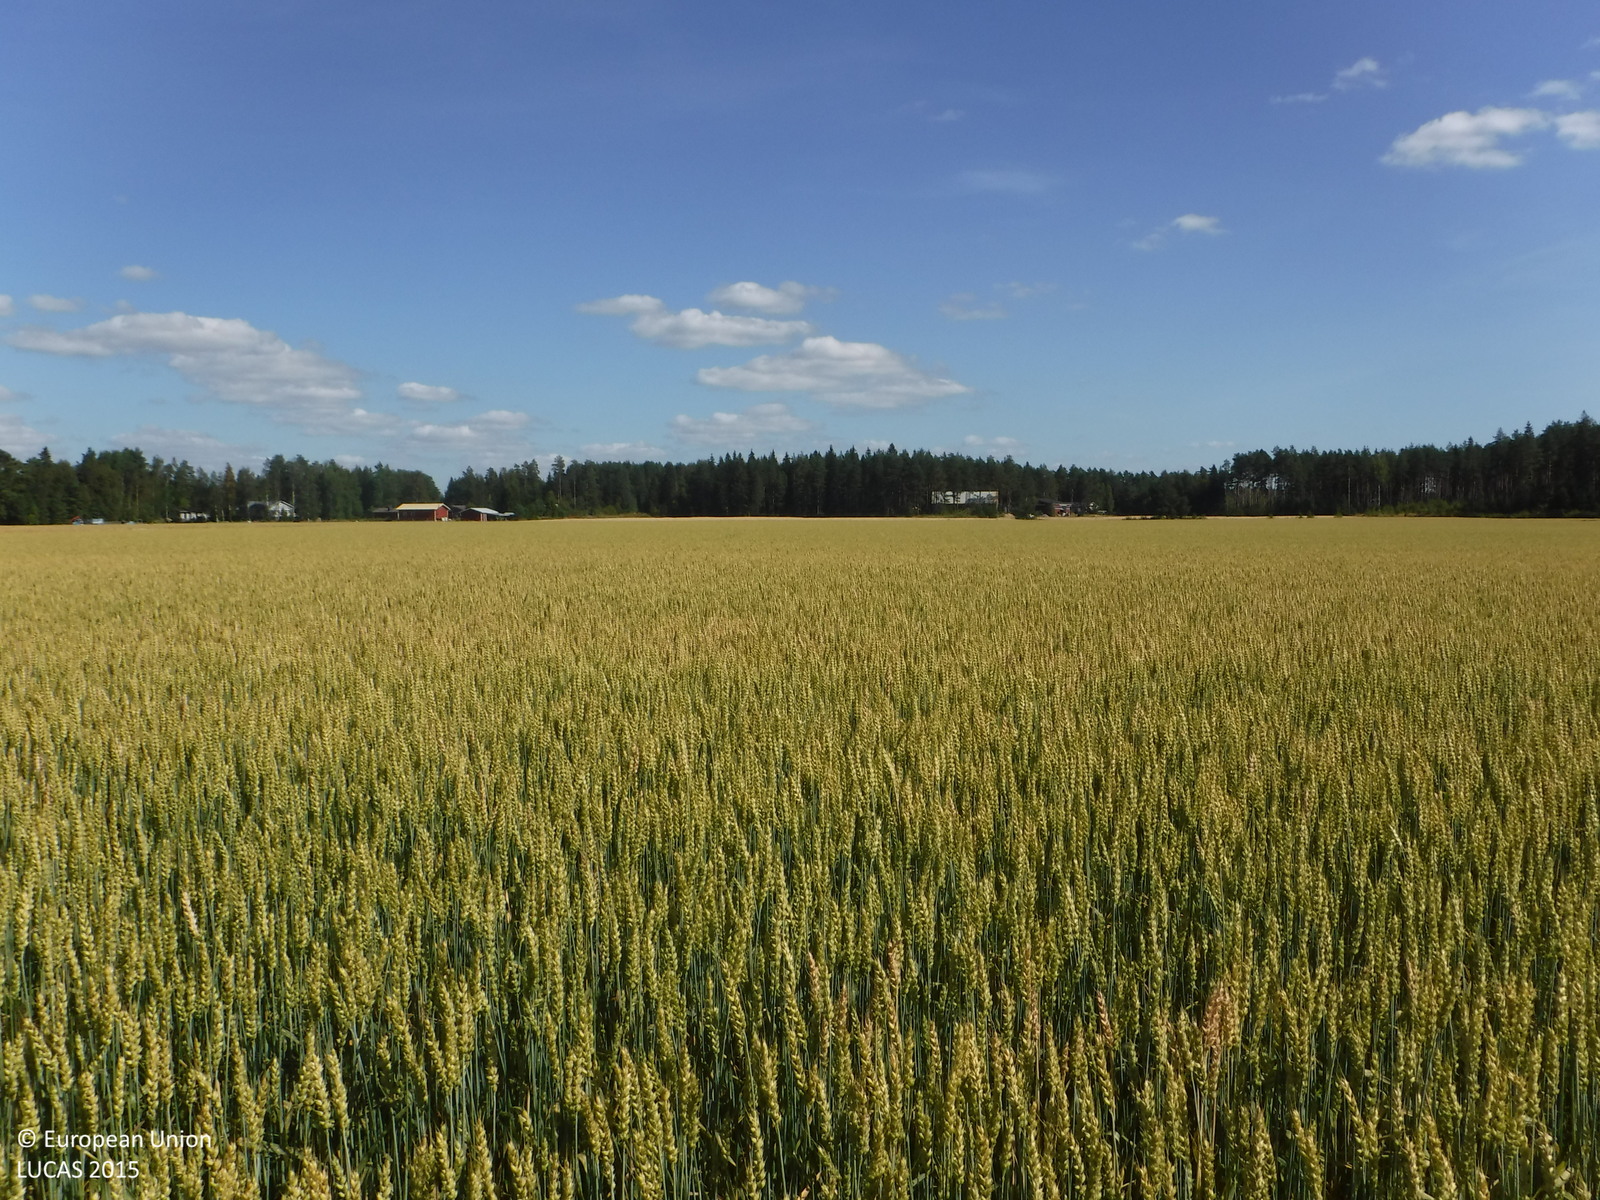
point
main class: Cropland
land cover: Common wheat
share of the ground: > 75 %
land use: Agriculture (excluding fallow land and kitchen gardens)
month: August
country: FI
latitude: 61.1171
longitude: 22.1055
